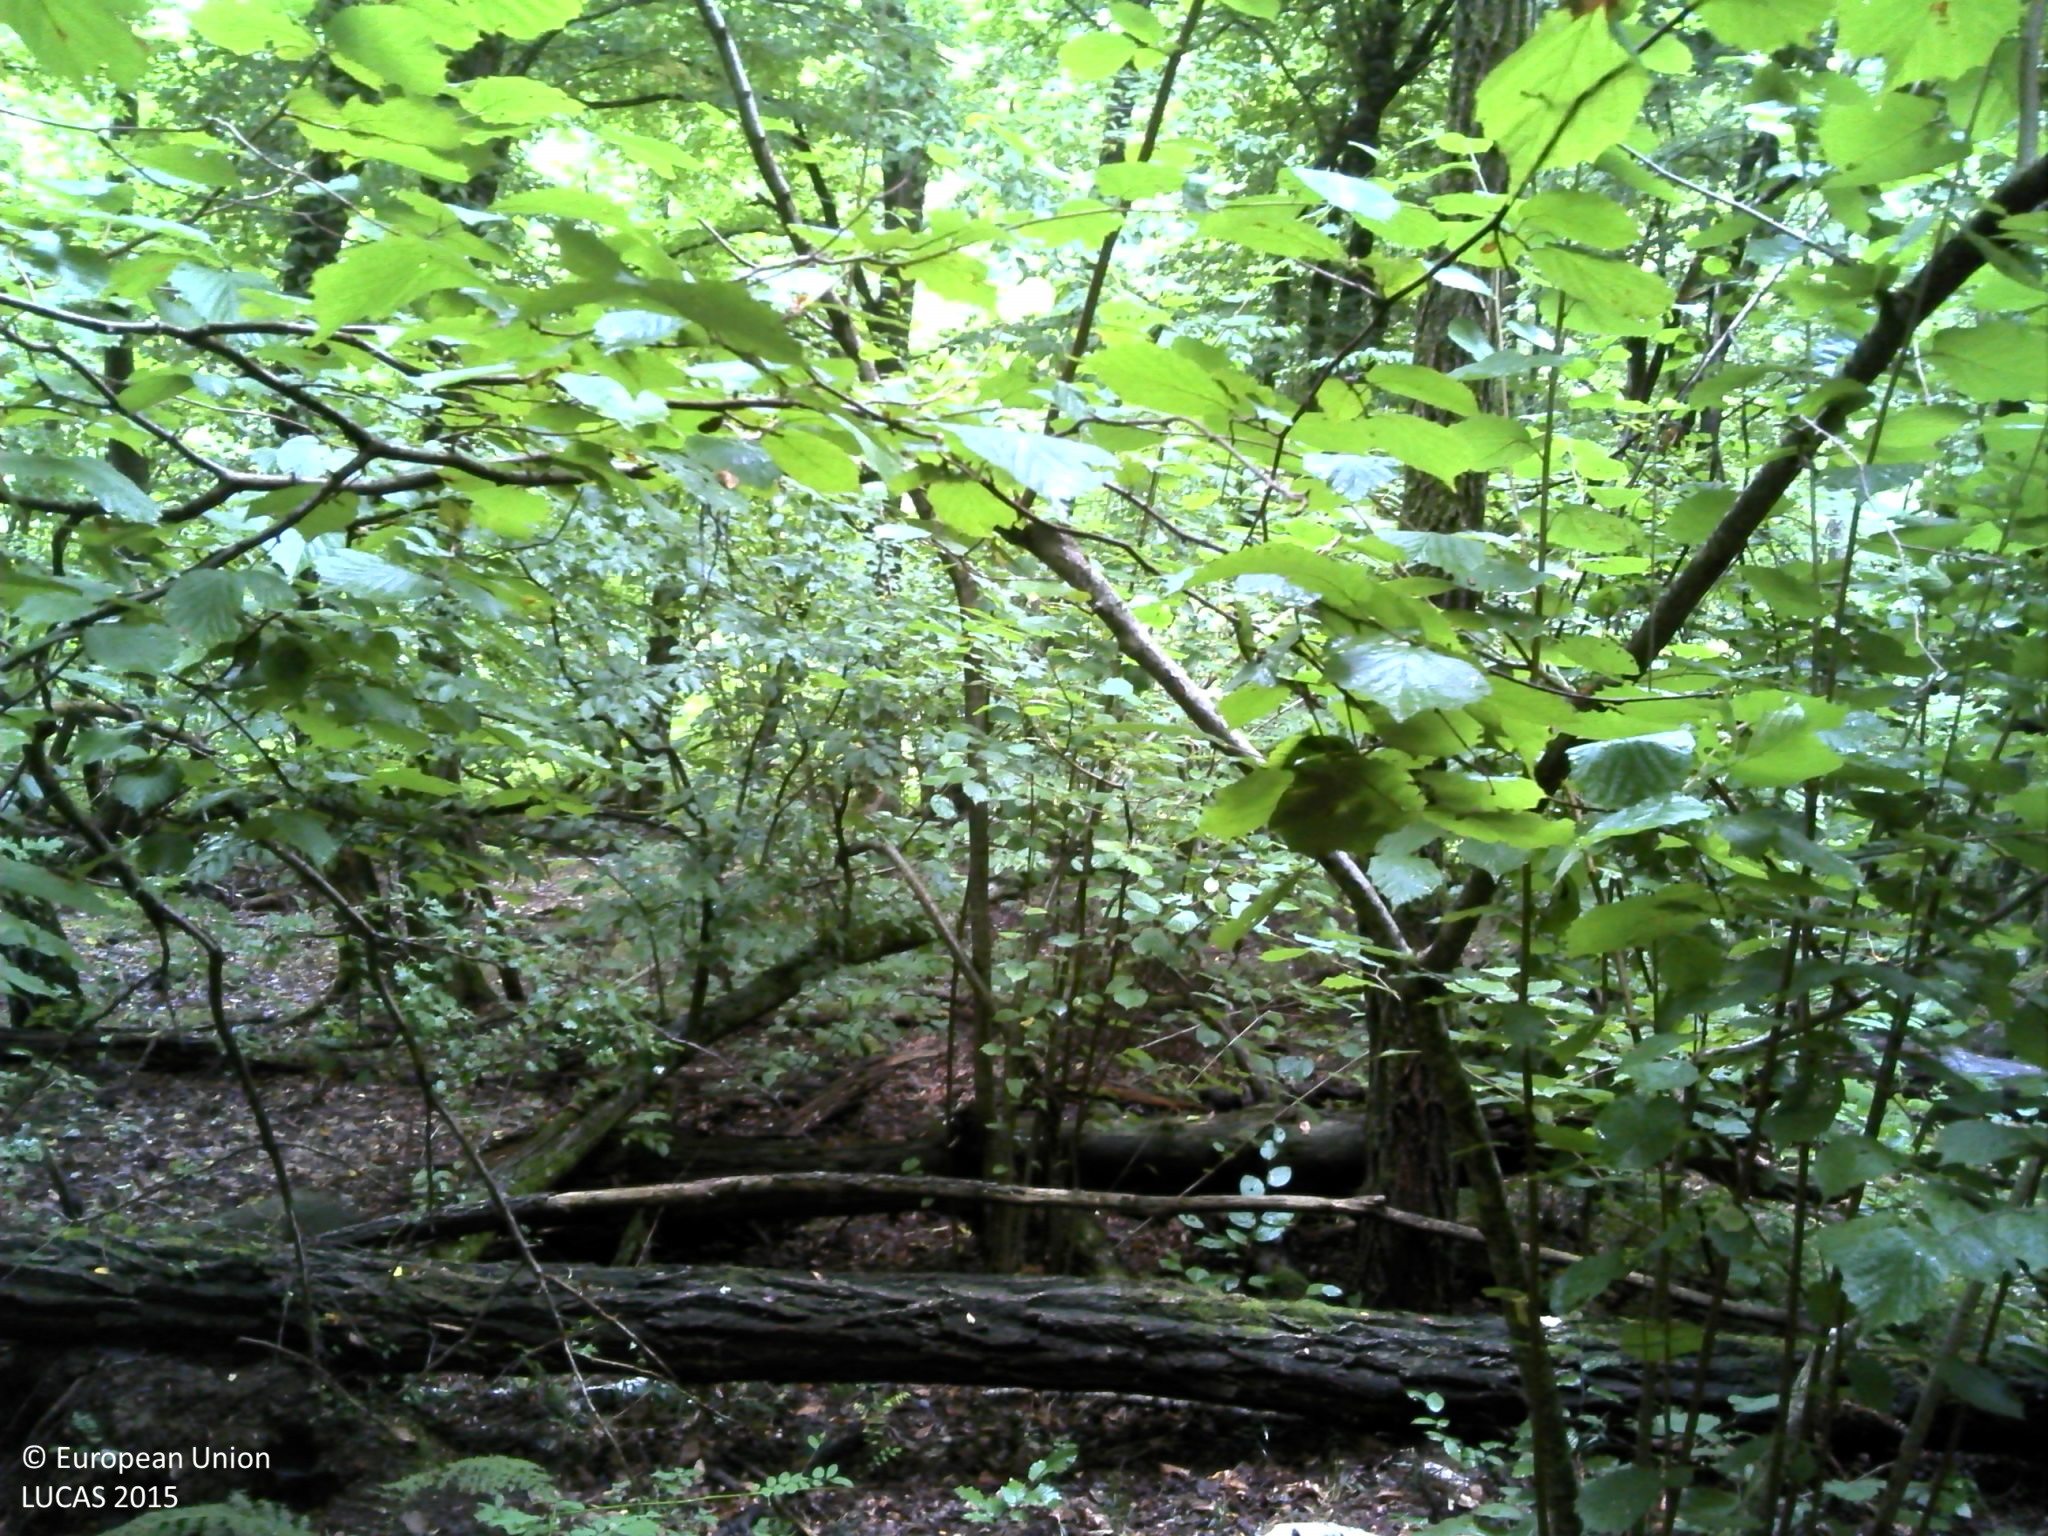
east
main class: Woodland
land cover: Broadleaved woodland
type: acidophilous oak and oak-birch forest
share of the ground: > 75 %
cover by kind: broadleaved forest trees 100 %
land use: Forestry
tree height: > 5 m
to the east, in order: Broadleaved woodland; Paved roads, cycling and walking lanes; Broadleaved woodland; Spontaneously vegetated surfaces
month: August
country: HR
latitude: 45.4263
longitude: 15.6326
